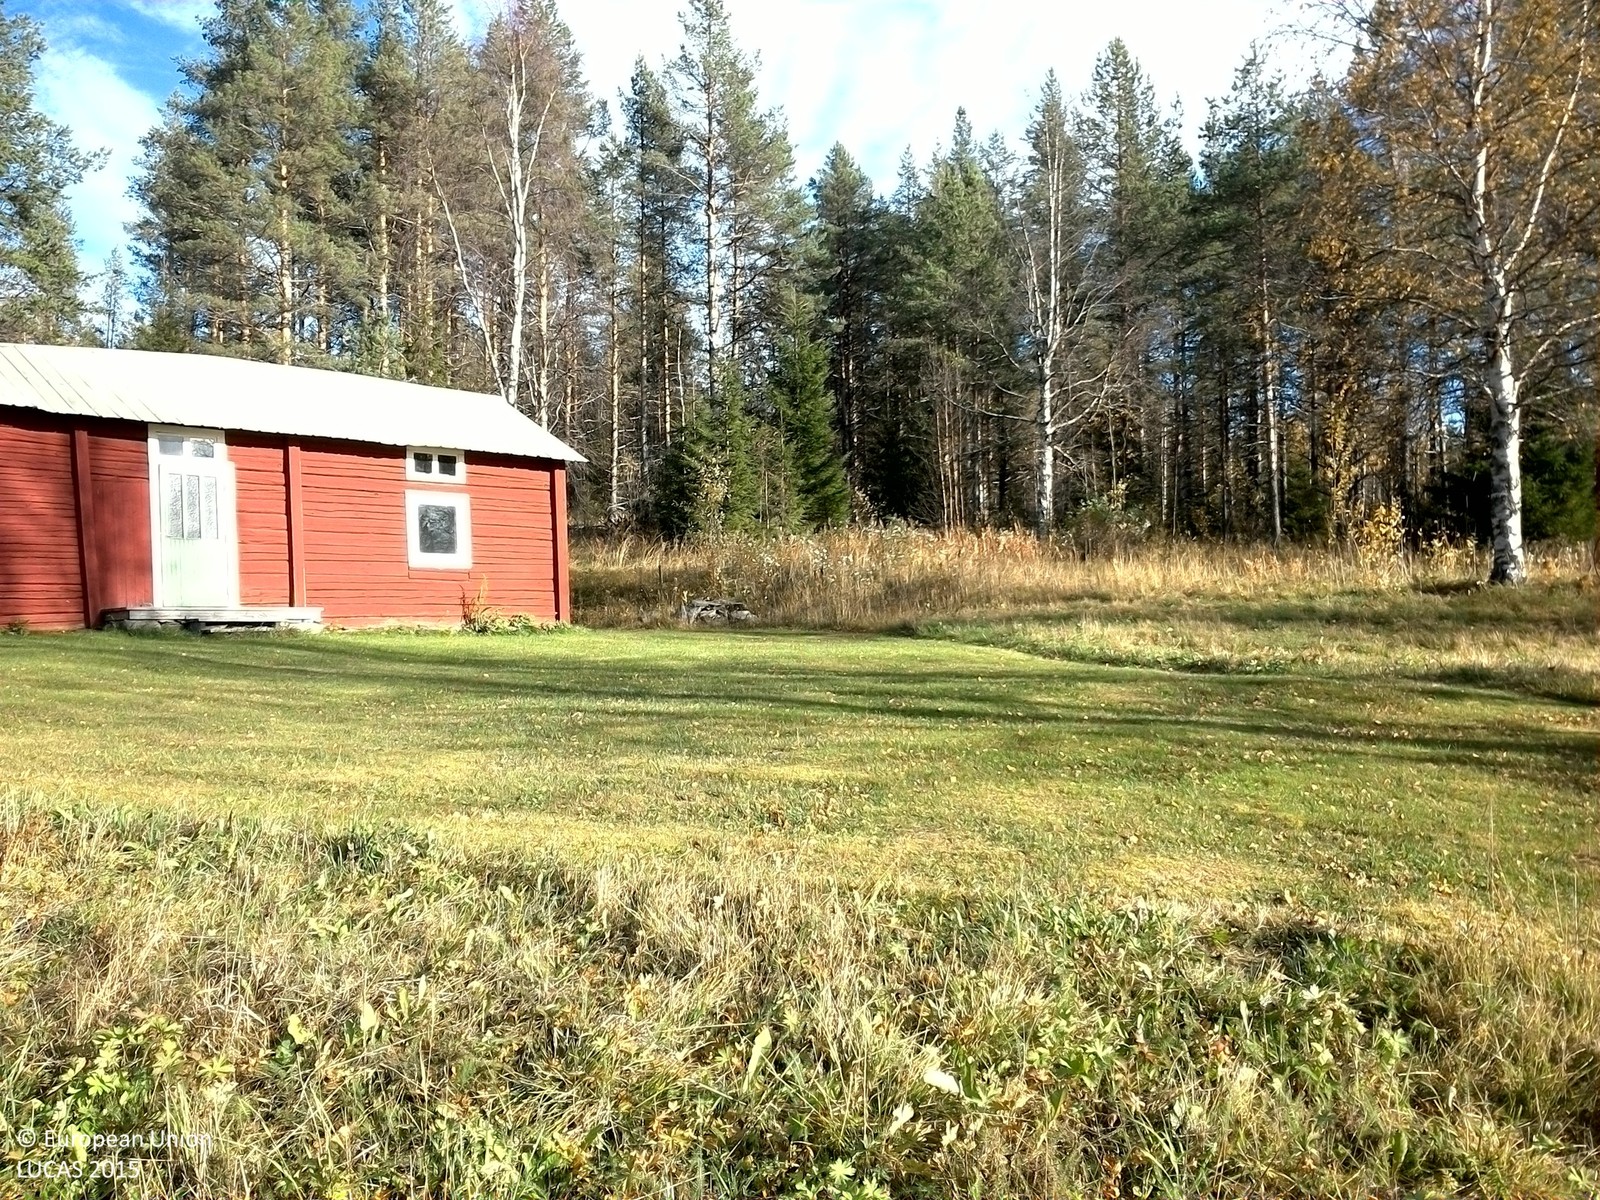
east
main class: Grassland
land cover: Grassland without tree/shrub cover
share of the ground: > 75 %
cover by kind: herbaceous plants 100 %
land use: Residential
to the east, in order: Grassland without tree/shrub cover; Grassland with sparse tree/shrub cover; Pine dominated coniferous woodland; Shrubland with sparse tree cover; Electric lines; Shrubland with sparse tree cover; Pine dominated coniferous woodland
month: October
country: SE
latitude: 64.4067
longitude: 15.6344
